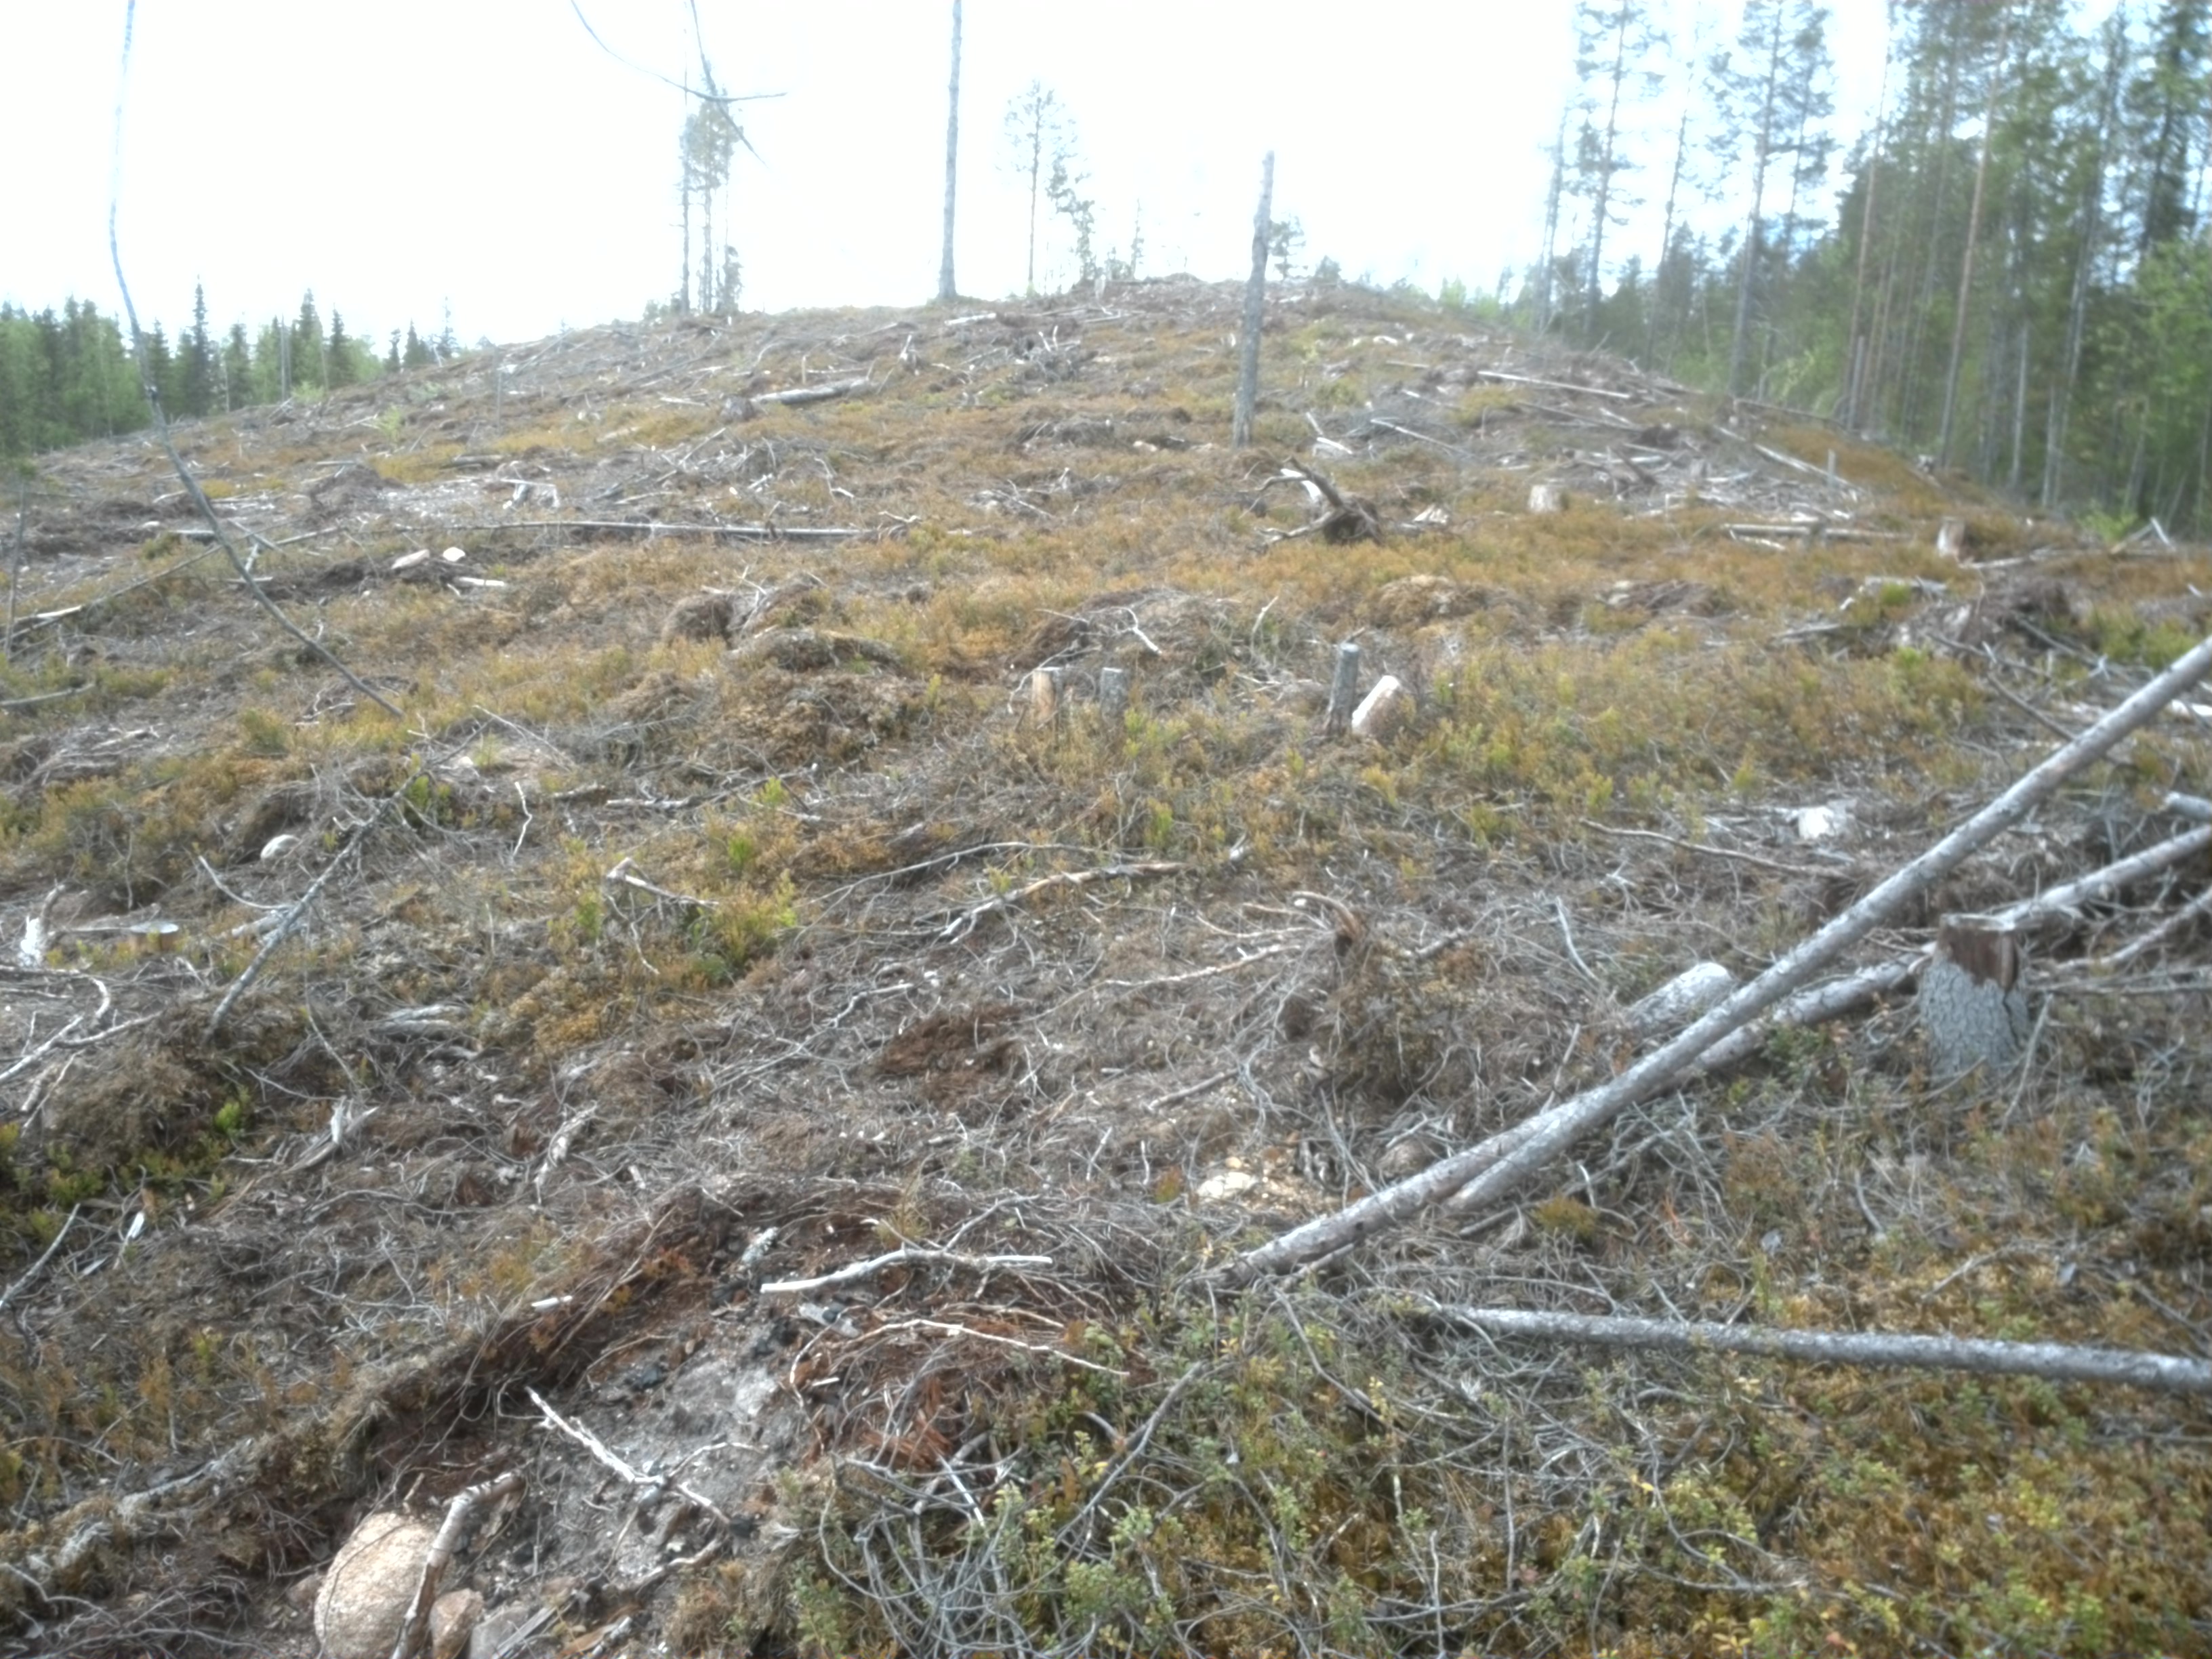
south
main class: Shrubland
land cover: Shrubland with sparse tree cover
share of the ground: 50 - 75 %
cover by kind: shrubs 60 %, unconsolidated bare surface 35 %, coniferous forest trees 5 %
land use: Forestry
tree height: > 5 m
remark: Clear cut
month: June
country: SE
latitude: 66.9980
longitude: 21.8148
